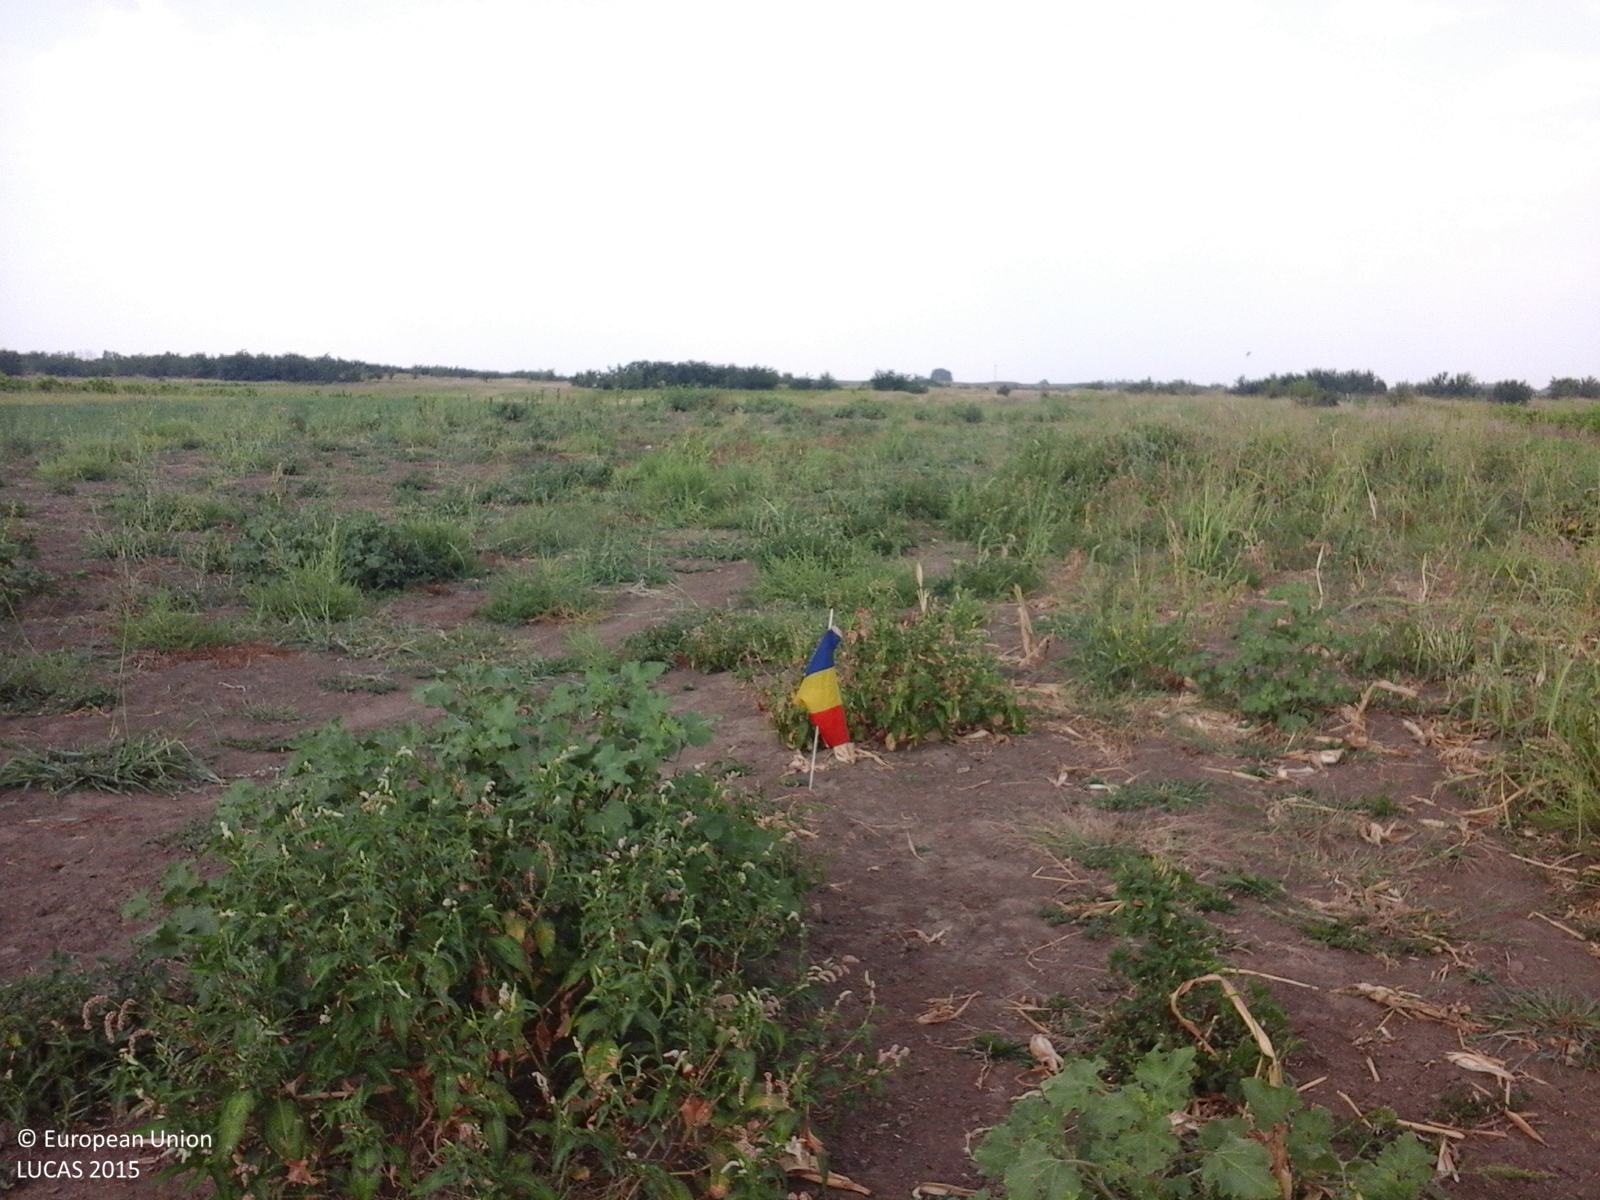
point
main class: Grassland
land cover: Spontaneously vegetated surfaces
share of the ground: 50 - 75 %
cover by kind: herbaceous plants 75 %, consolidated bare surface 25 %
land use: Agriculture (excluding fallow land and kitchen gardens)
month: August
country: RO
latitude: 43.9054
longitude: 23.0528
